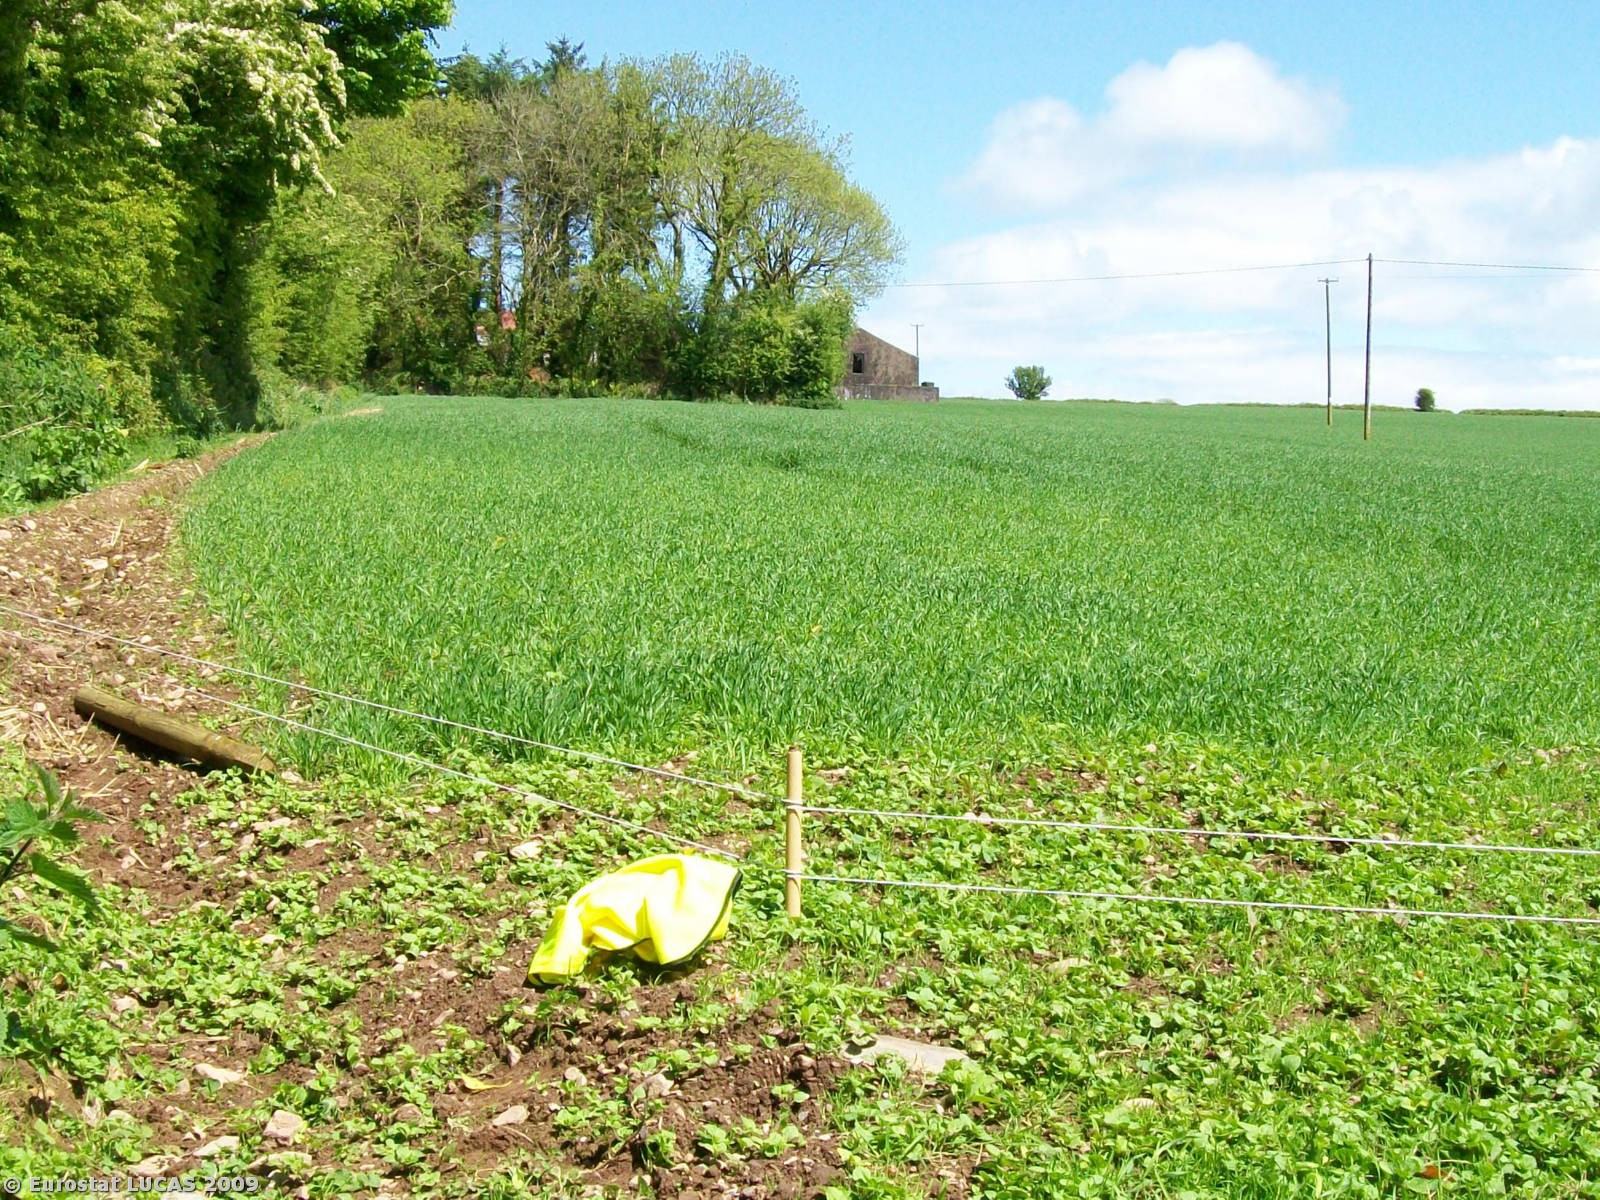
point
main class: Cropland
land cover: Common wheat
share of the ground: > 75 %
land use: Agriculture (excluding fallow land and kitchen gardens)
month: May
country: IE
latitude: 51.8321
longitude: -8.7037
